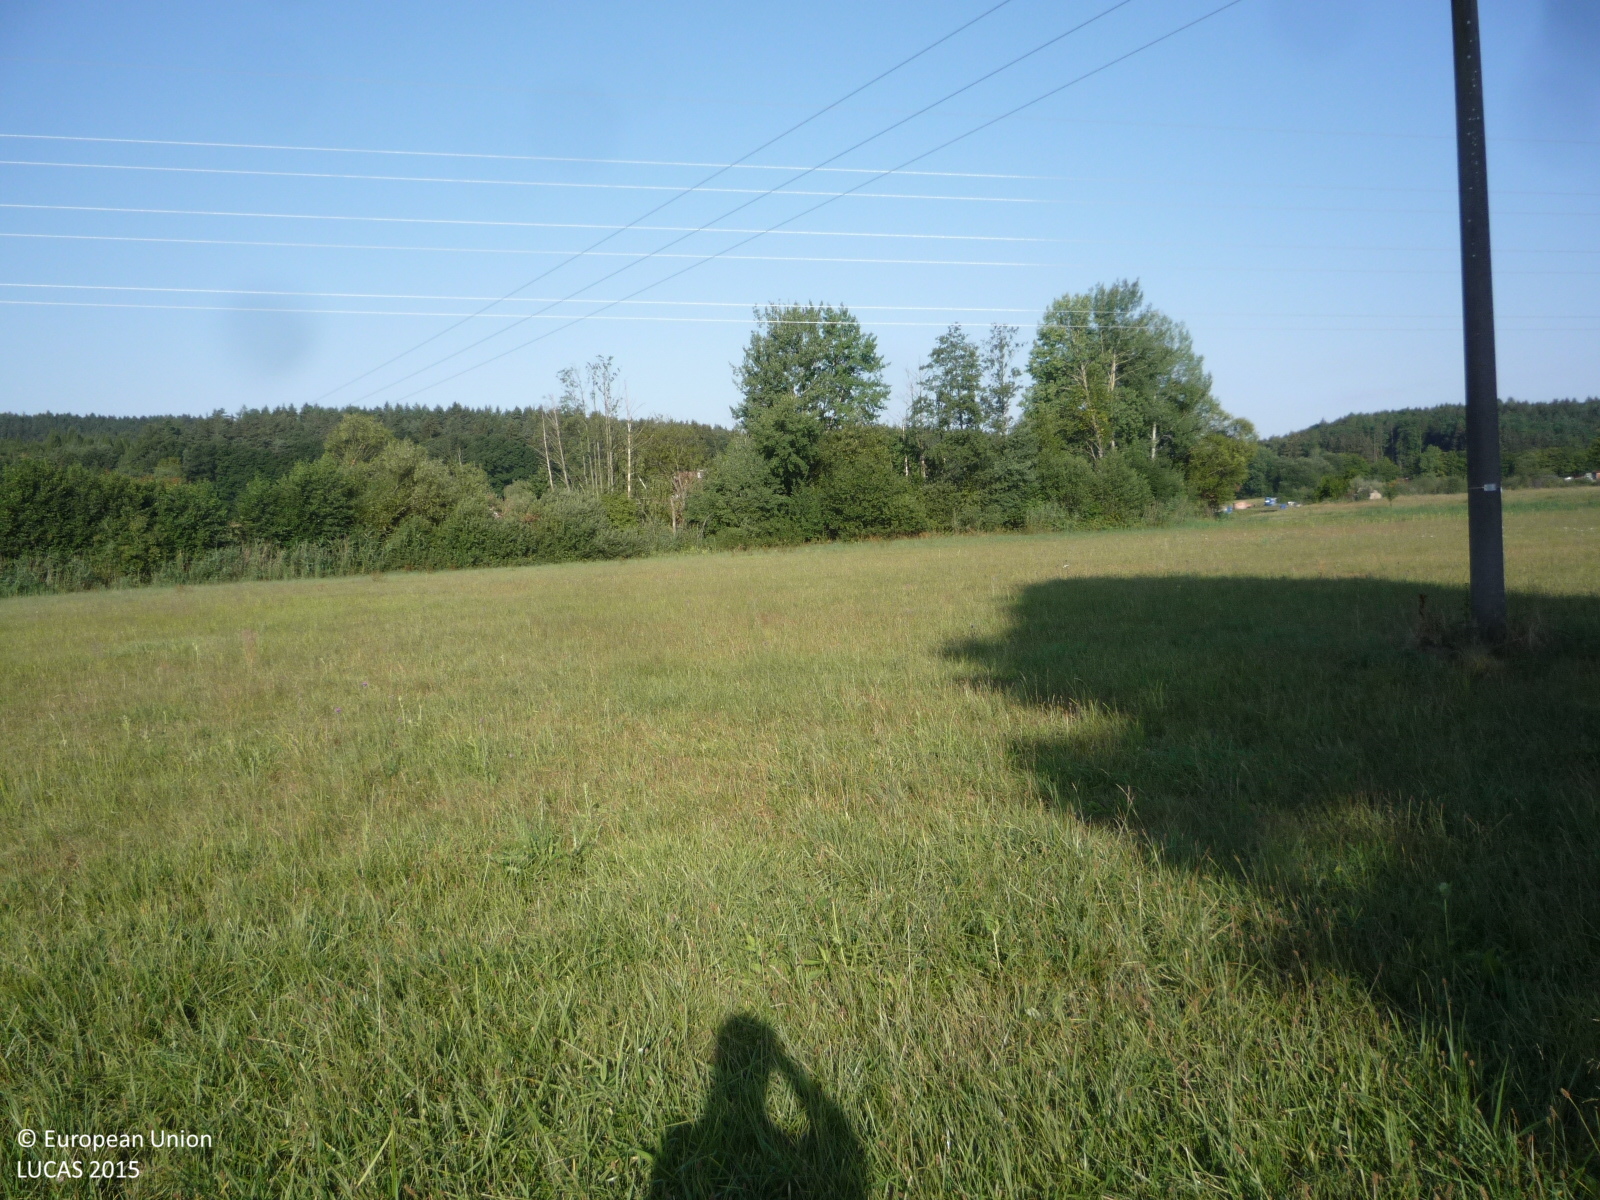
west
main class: Grassland
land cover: Grassland without tree/shrub cover
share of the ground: > 75 %
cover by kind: herbaceous plants 100 %
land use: Agriculture (excluding fallow land and kitchen gardens)
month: July
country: CZ
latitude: 50.4402
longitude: 15.2837
